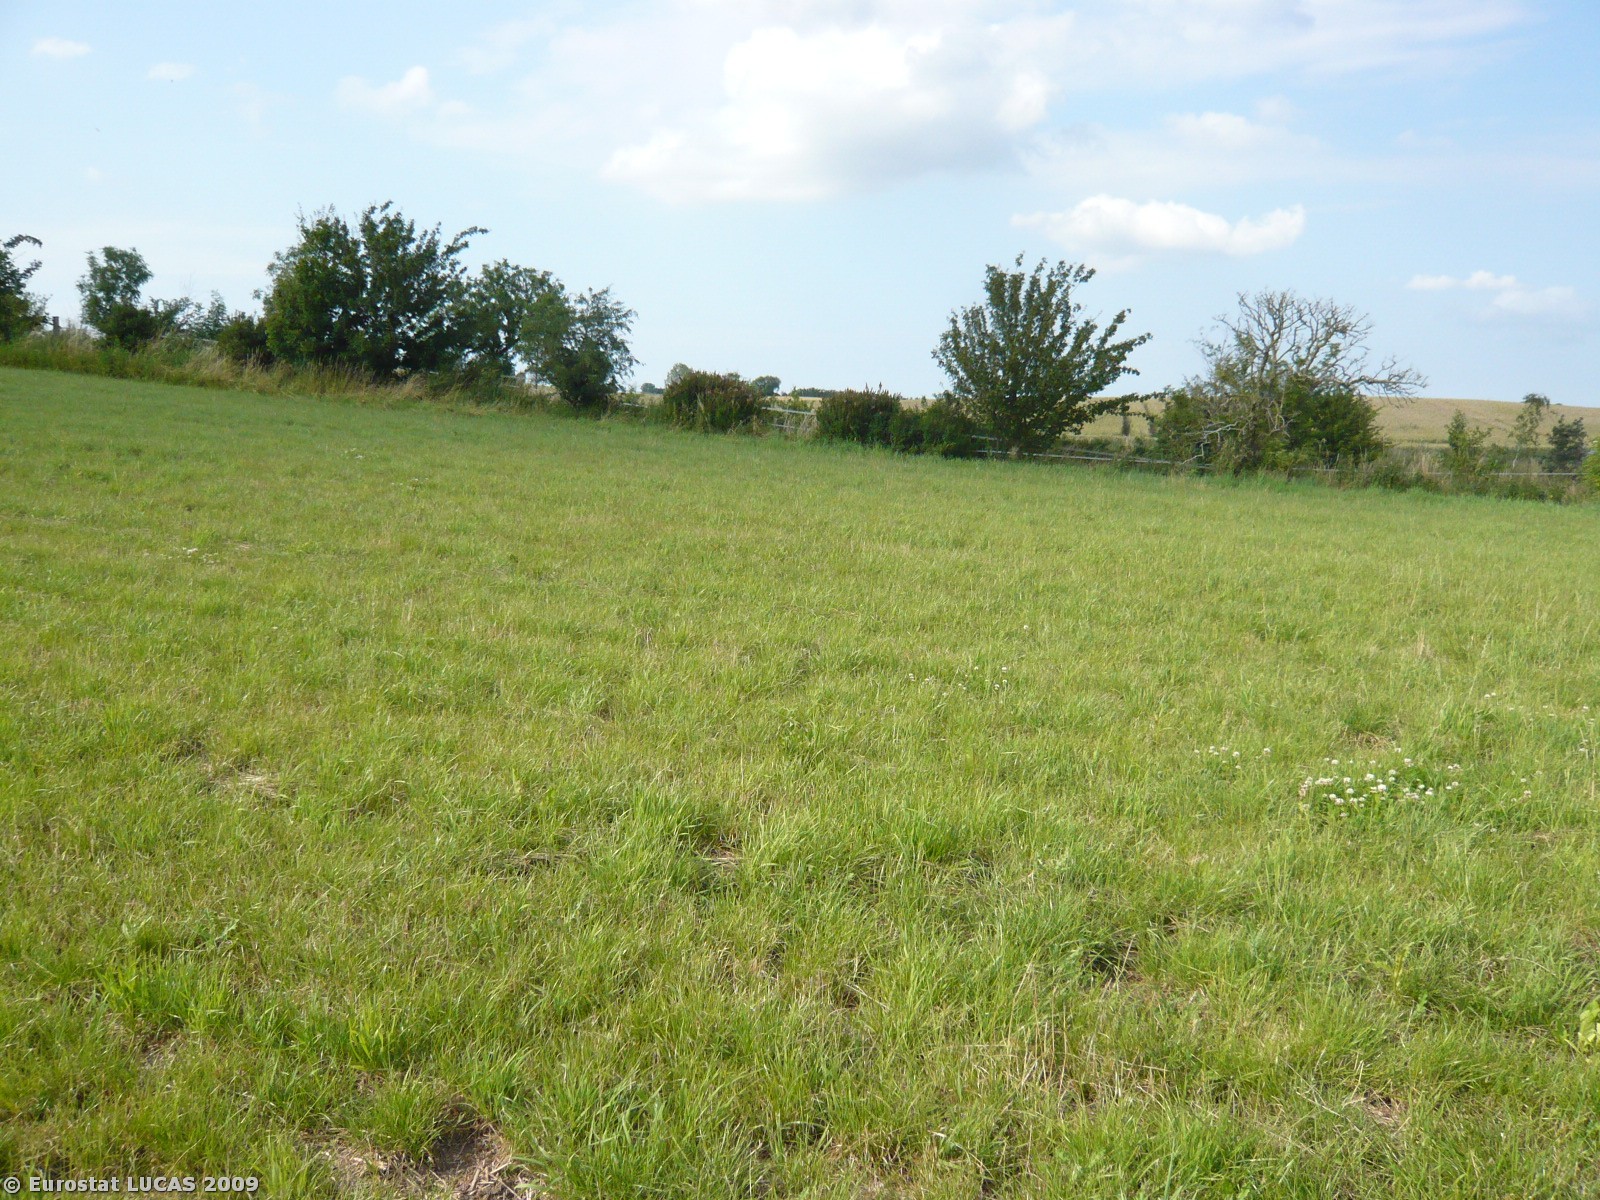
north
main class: Grassland
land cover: Grassland without tree/shrub cover
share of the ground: > 75 %
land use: Agriculture (excluding fallow land and kitchen gardens)
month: July
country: DK
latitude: 55.8540
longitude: 11.6118
